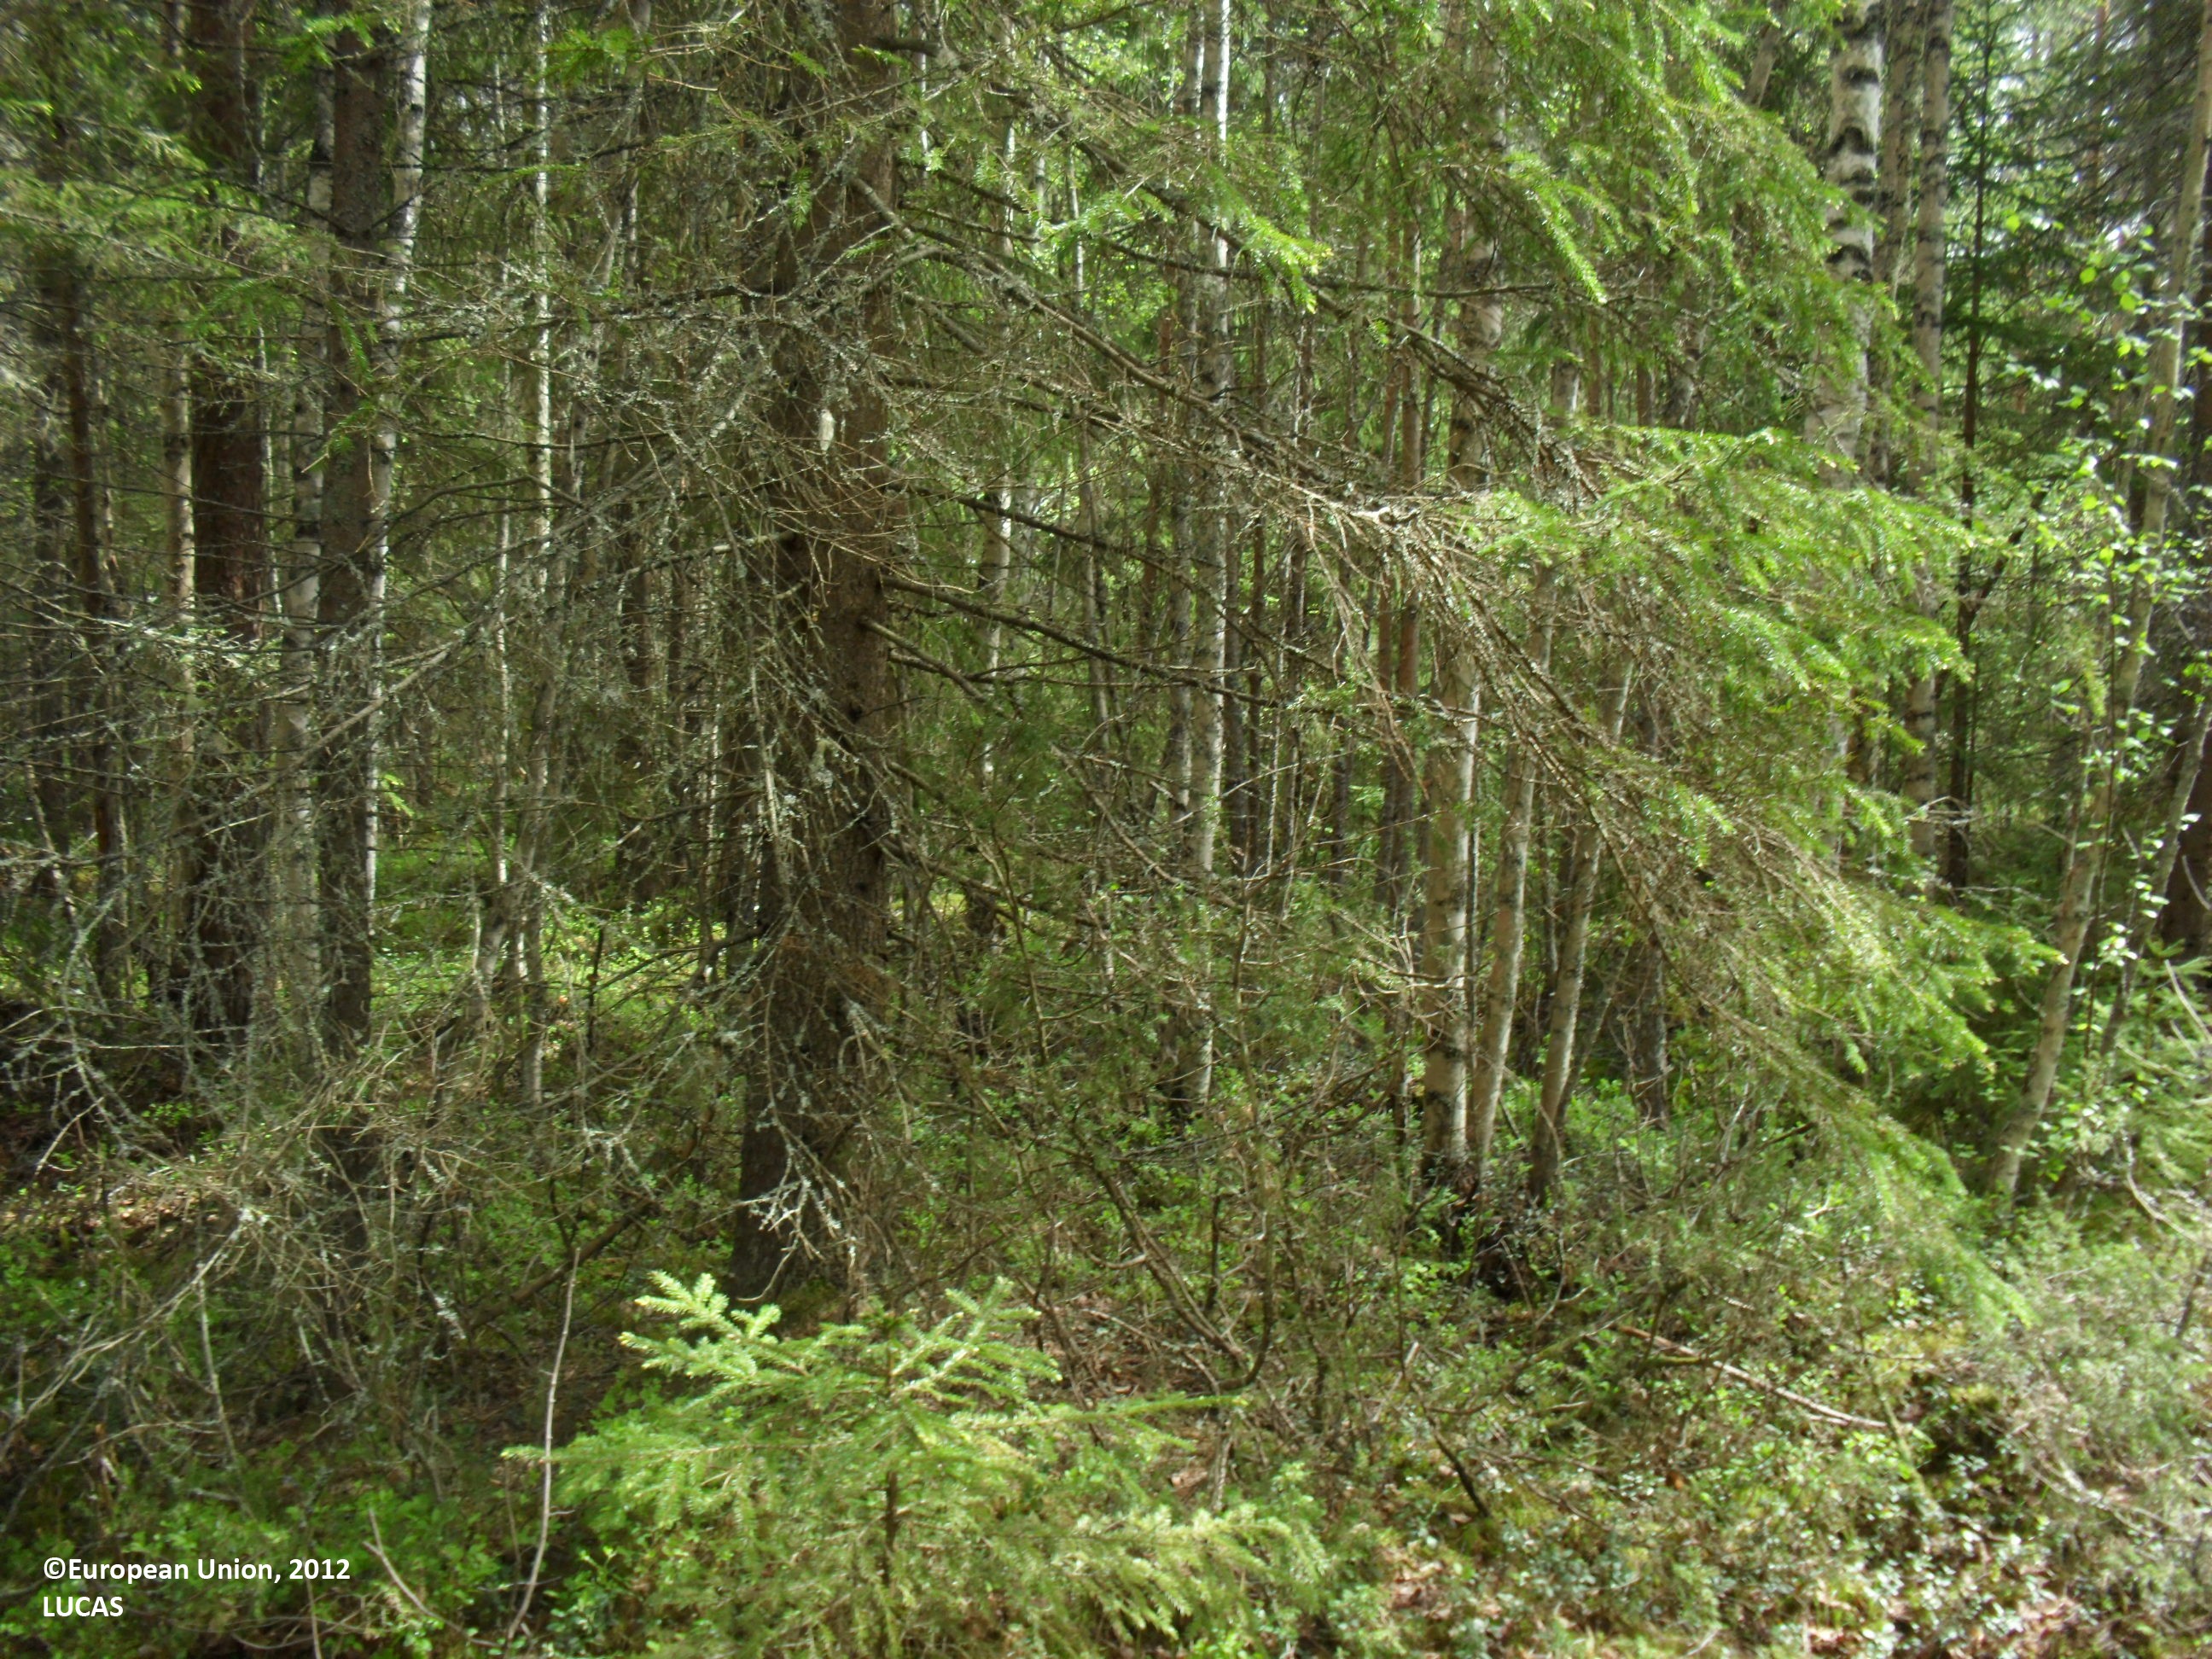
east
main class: Woodland
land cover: Spruce dominated mixed woodland
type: boreal forest
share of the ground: > 75 %
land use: Forestry
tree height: > 5 m
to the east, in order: Spruce dominated mixed woodland; Tracks; Spruce dominated mixed woodland; Pine dominated mixed woodland; Ditches and canals; Pine dominated mixed woodland; Tracks; Pine dominated mixed woodland
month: June
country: FI
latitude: 62.8742
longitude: 23.3750
